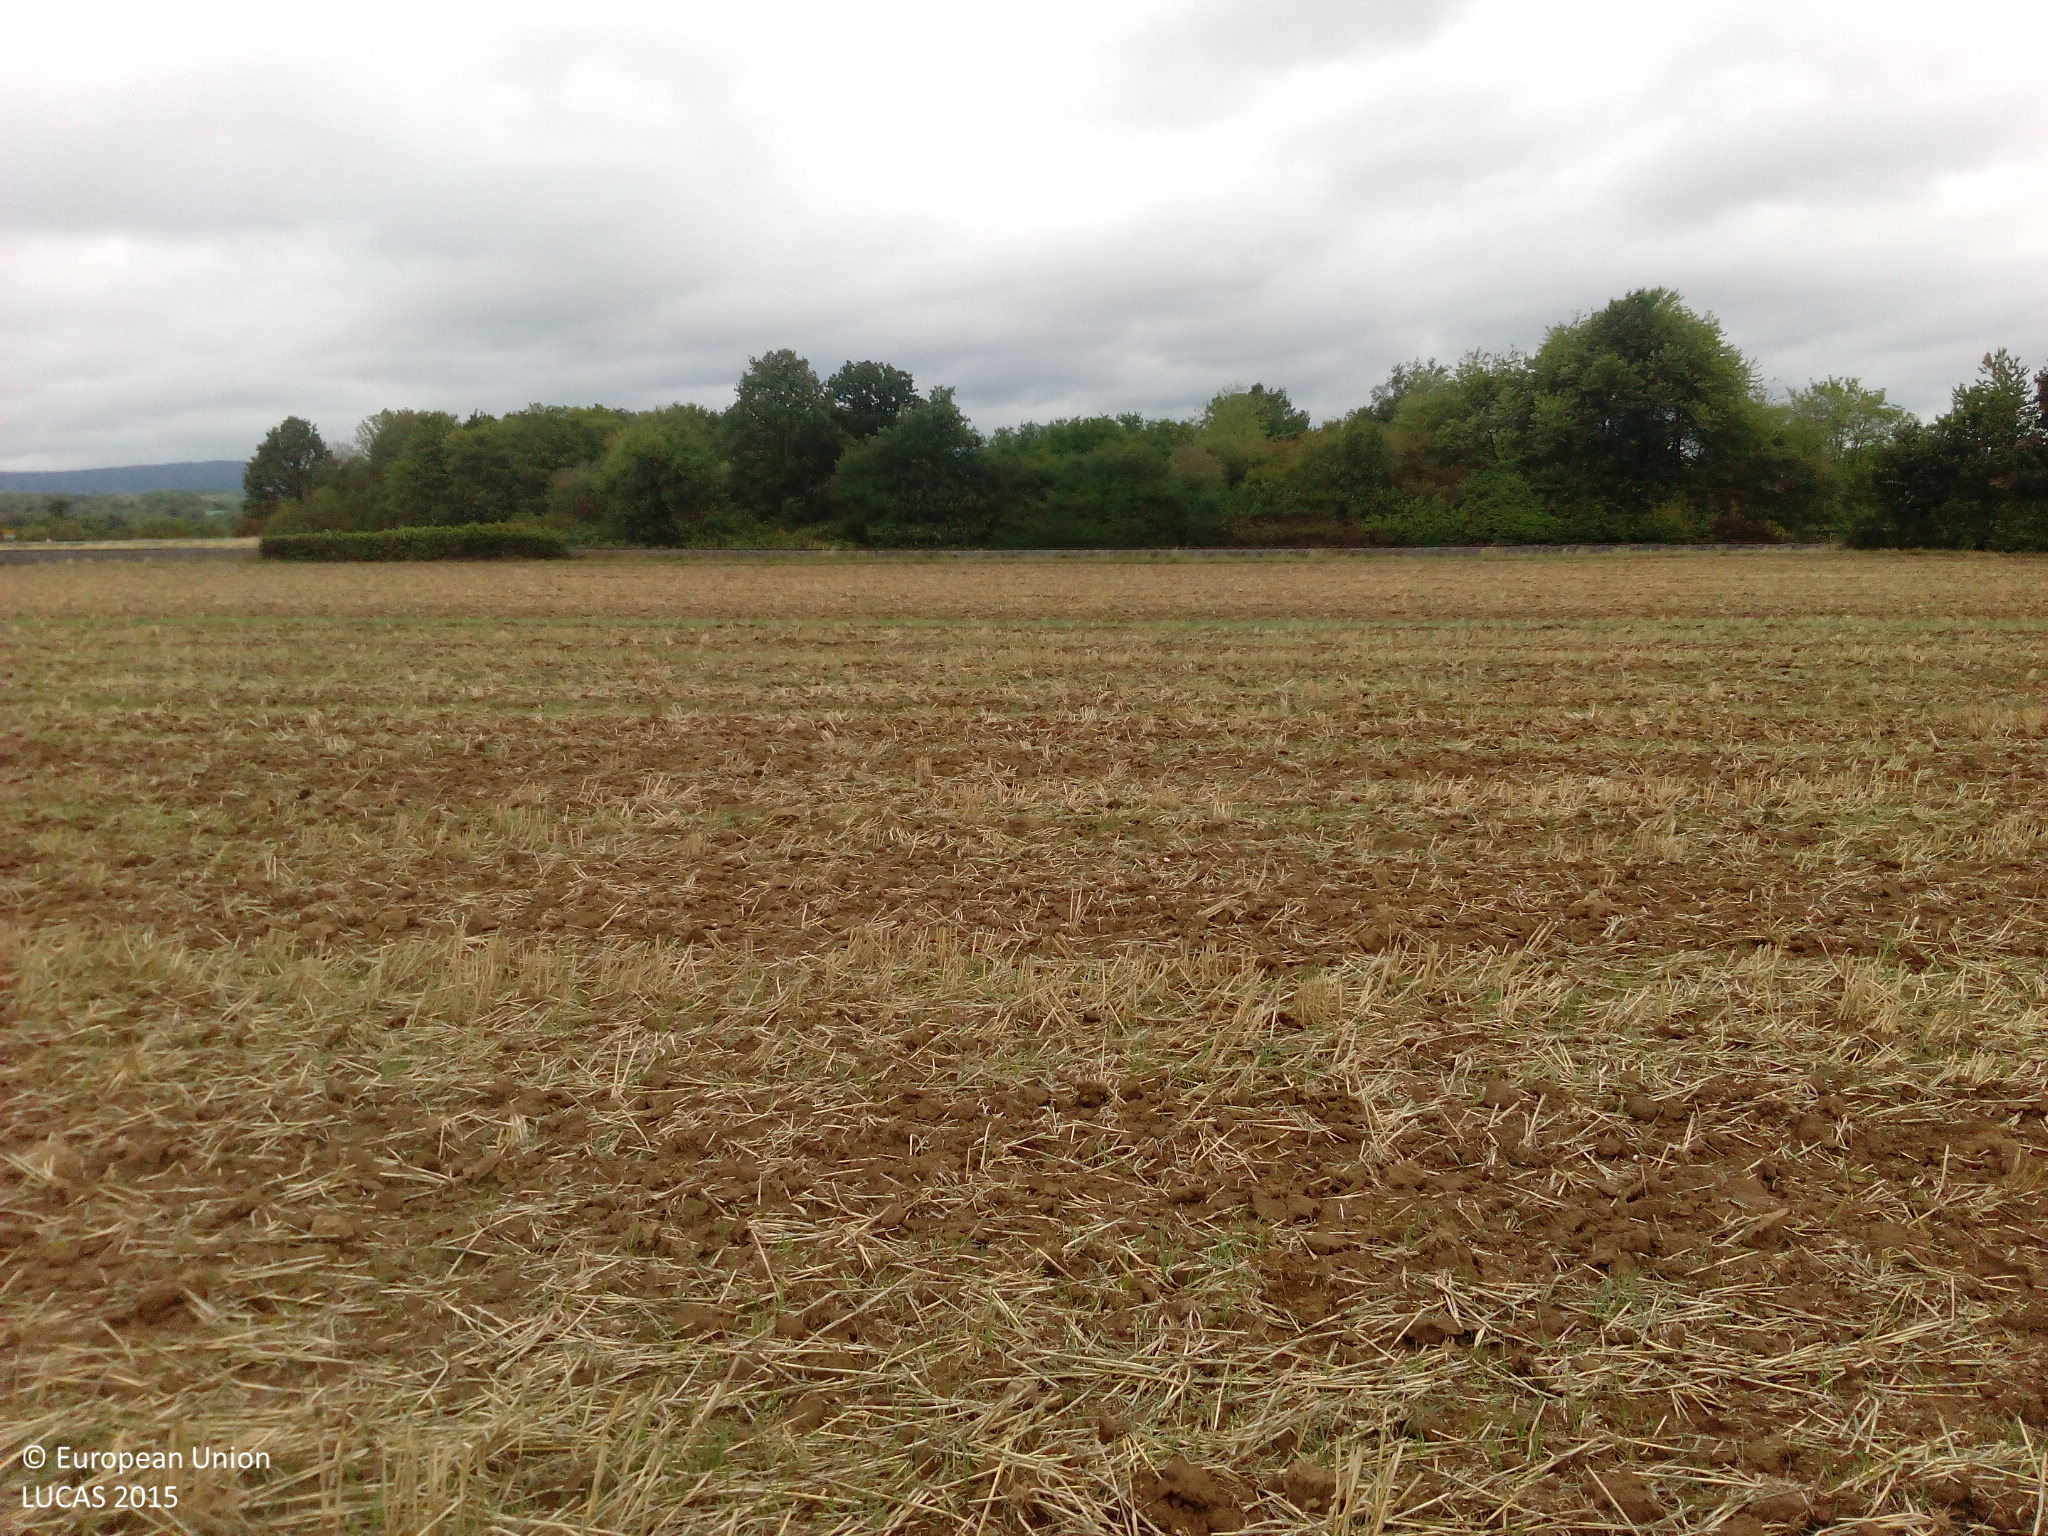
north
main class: Cropland
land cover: Common wheat
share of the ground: < 10 %
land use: Agriculture (excluding fallow land and kitchen gardens)
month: August
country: DE
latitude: 50.1201
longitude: 8.4759
